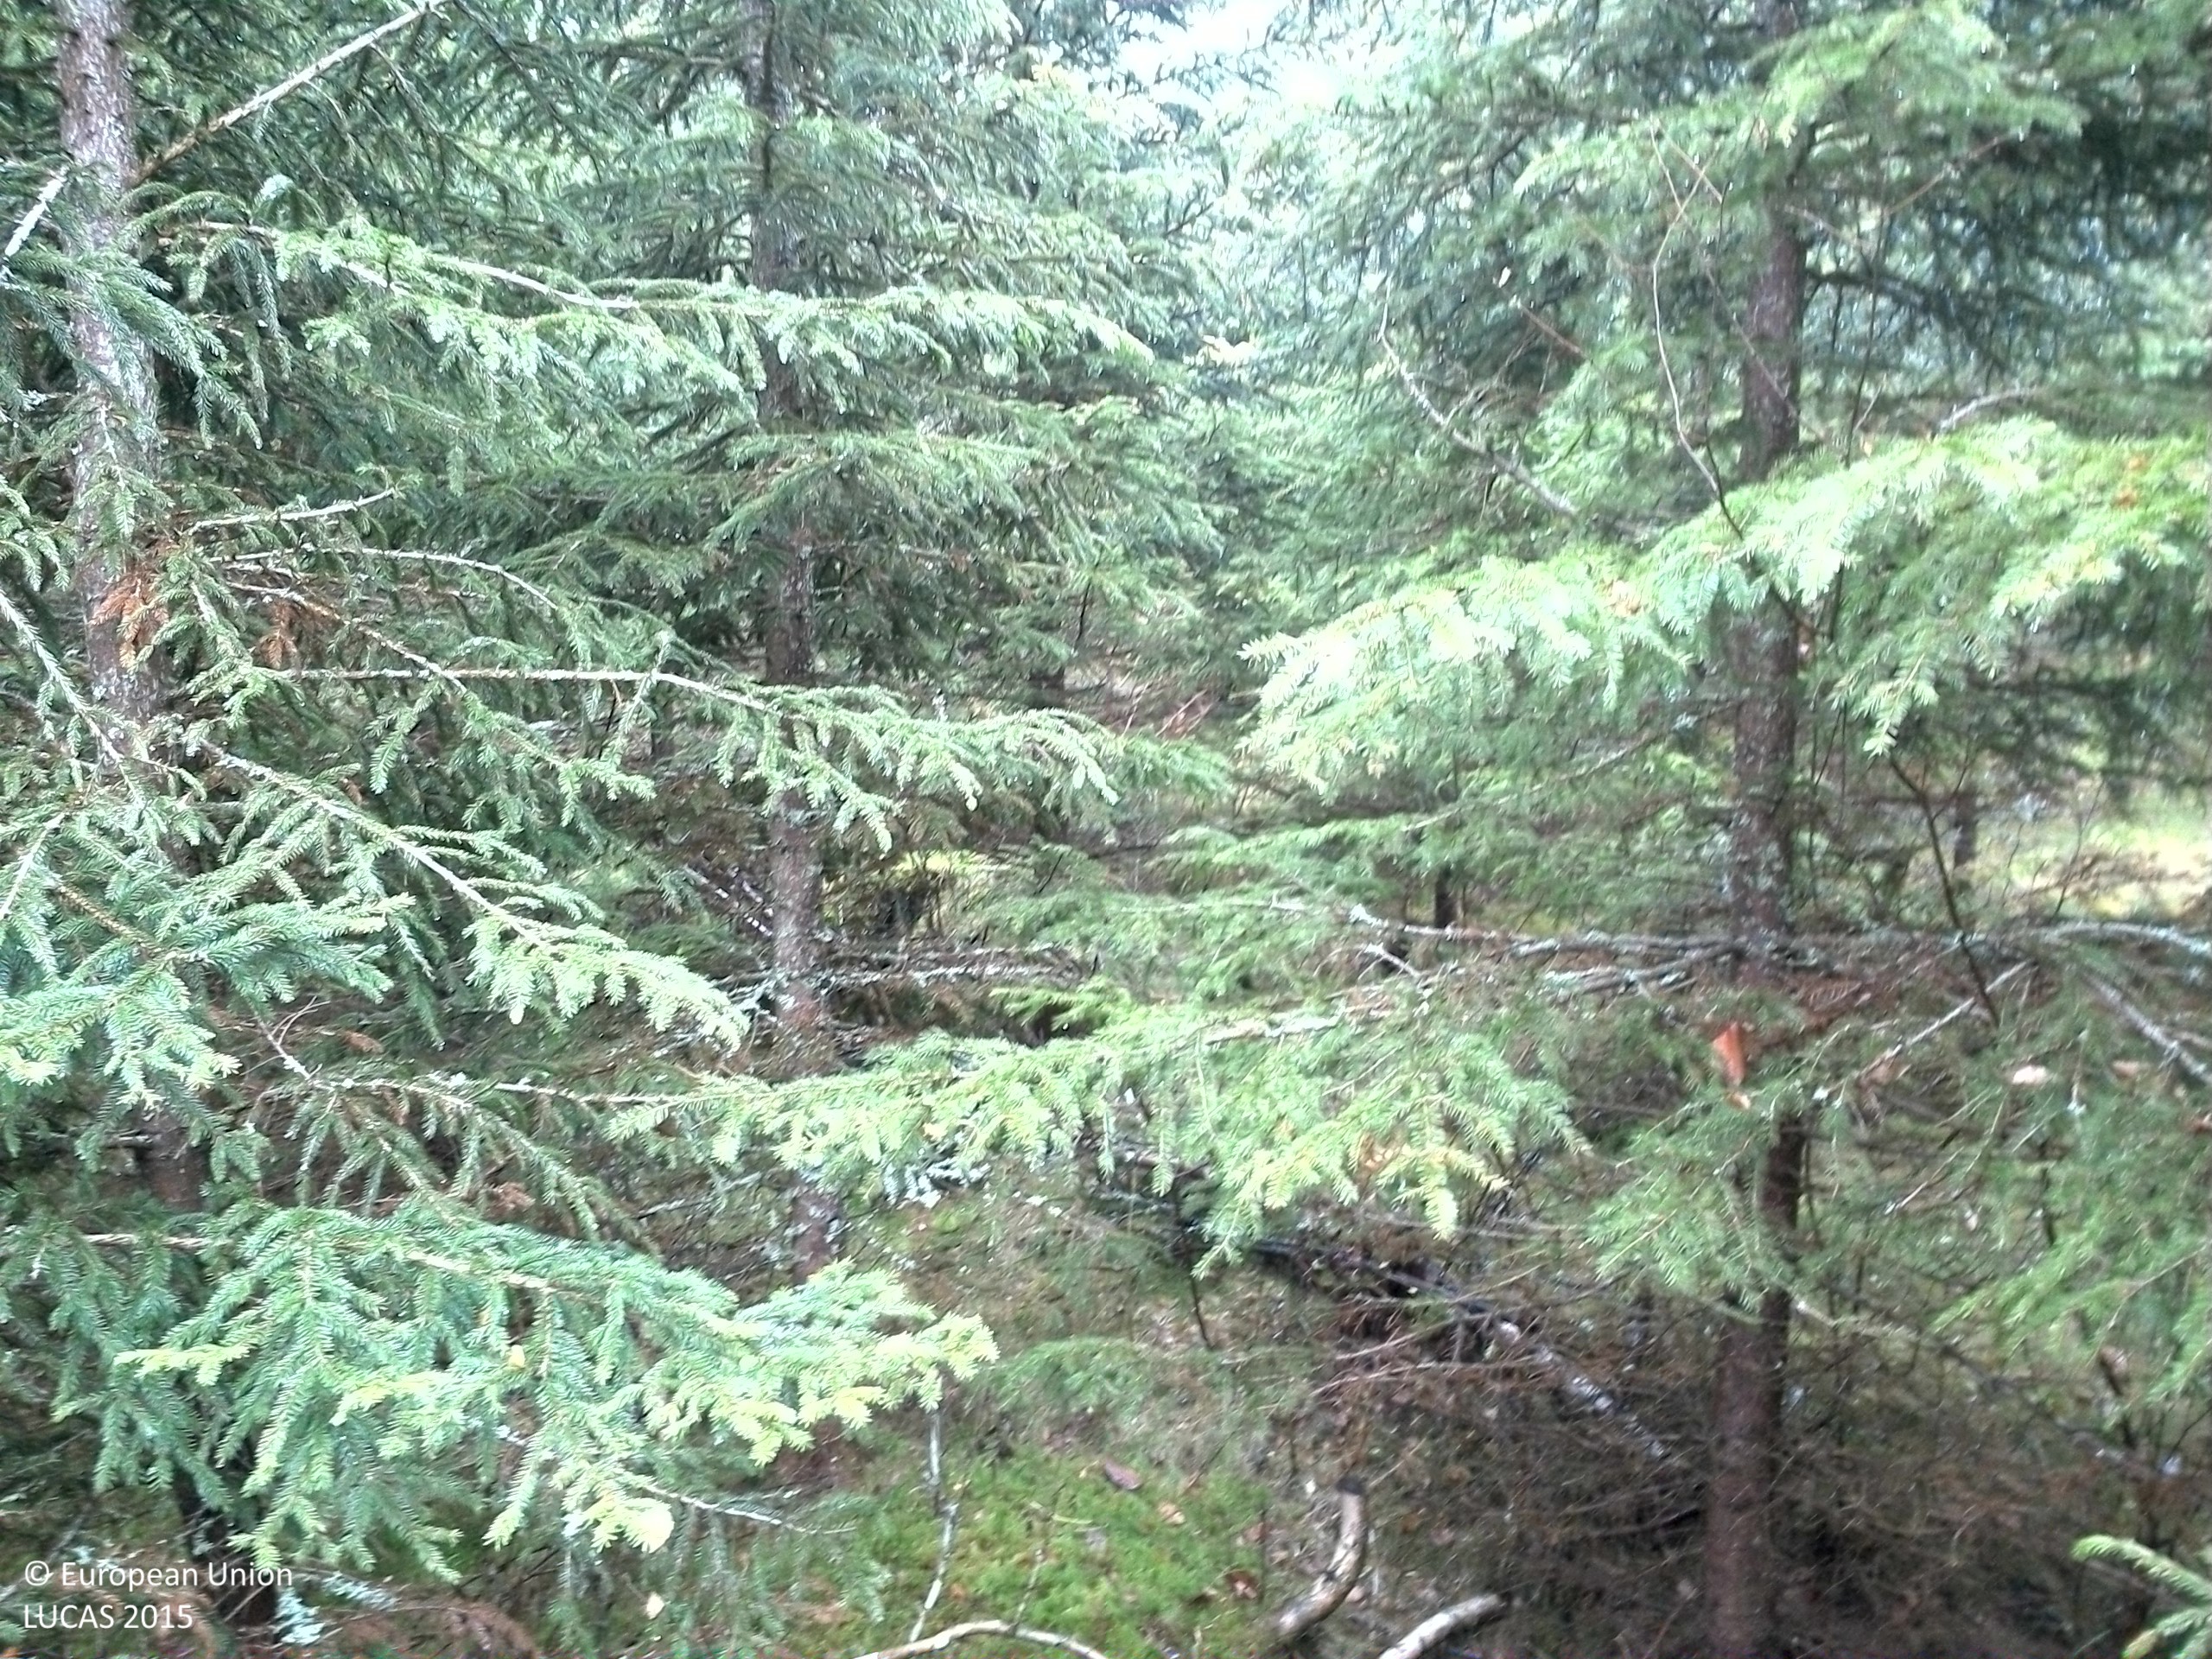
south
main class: Woodland
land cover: Spruce dominated coniferous woodland
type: boreal forest
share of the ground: > 75 %
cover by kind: coniferous forest trees 75 %, lichens and mosses 10 %, broadleaved forest trees 5 %, shrubs 5 %, herbaceous plants 5 %
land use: Forestry
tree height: < 5 m
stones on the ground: 10 - 25 %
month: November
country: SE
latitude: 57.8562
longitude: 15.0002
